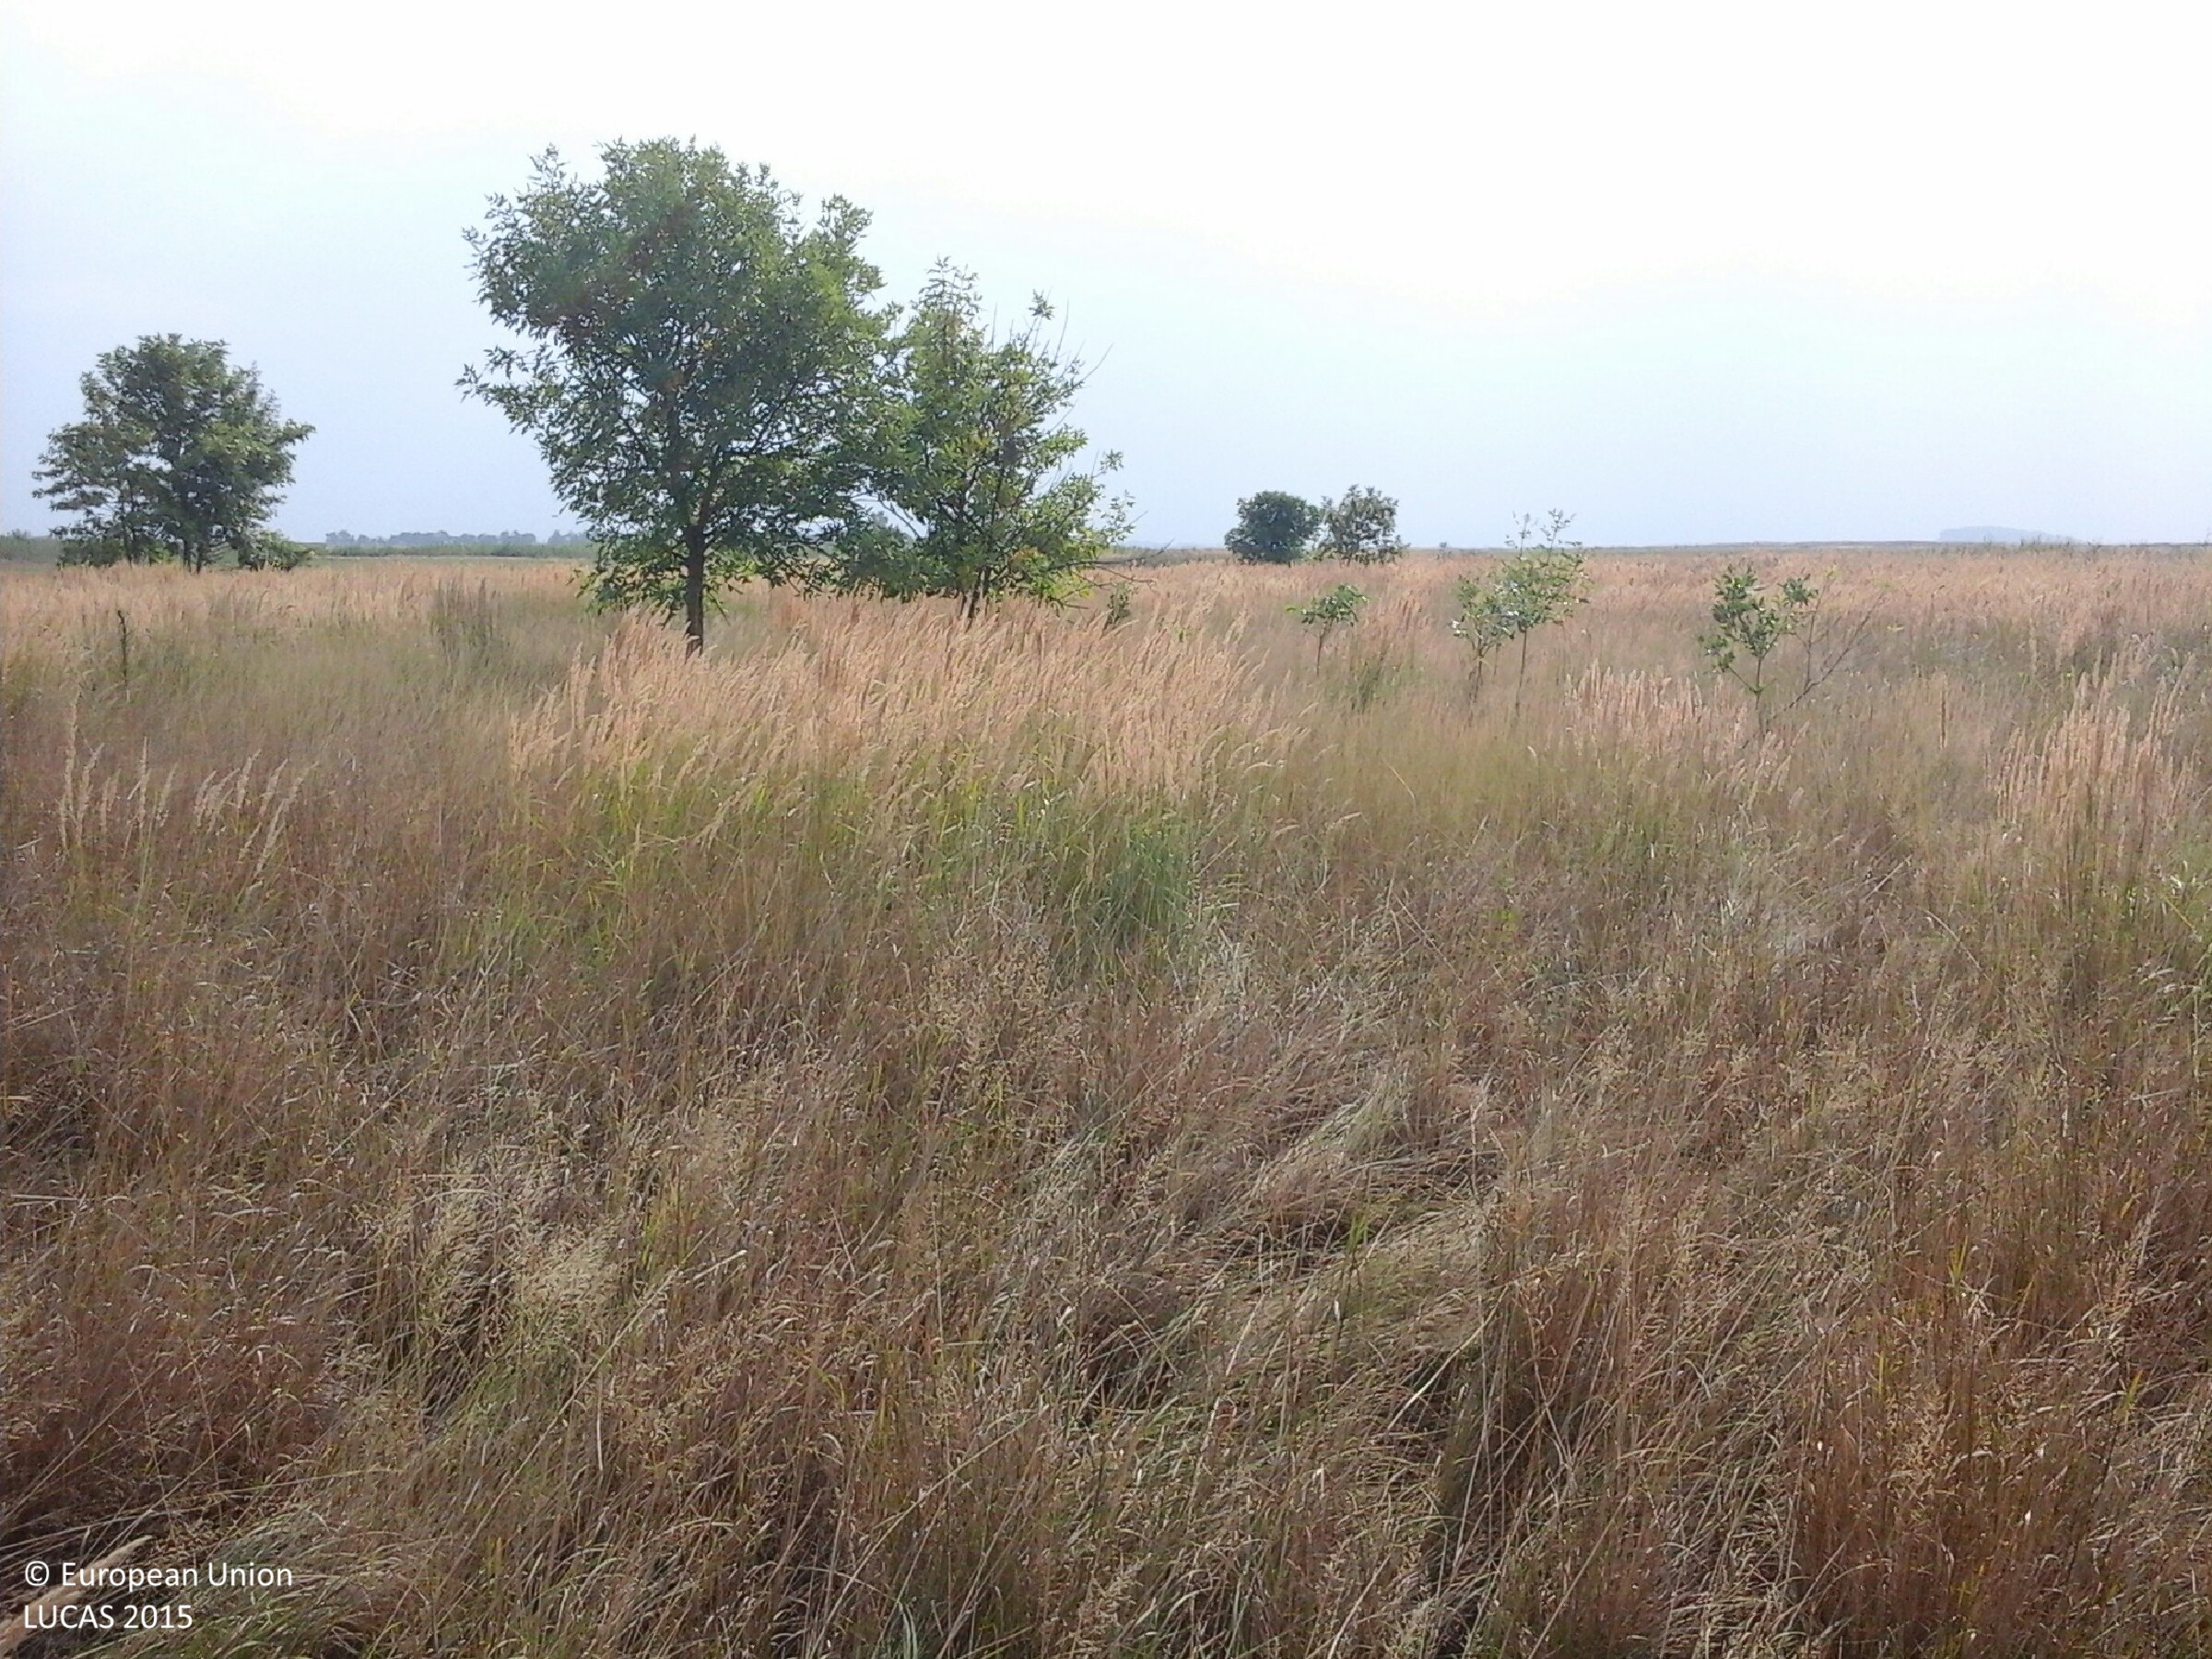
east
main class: Grassland
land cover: Grassland without tree/shrub cover
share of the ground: > 75 %
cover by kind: herbaceous plants 100 %
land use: Agriculture (excluding fallow land and kitchen gardens)
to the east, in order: Grassland without tree/shrub cover
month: August
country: HU
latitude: 47.5497
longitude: 20.9454
